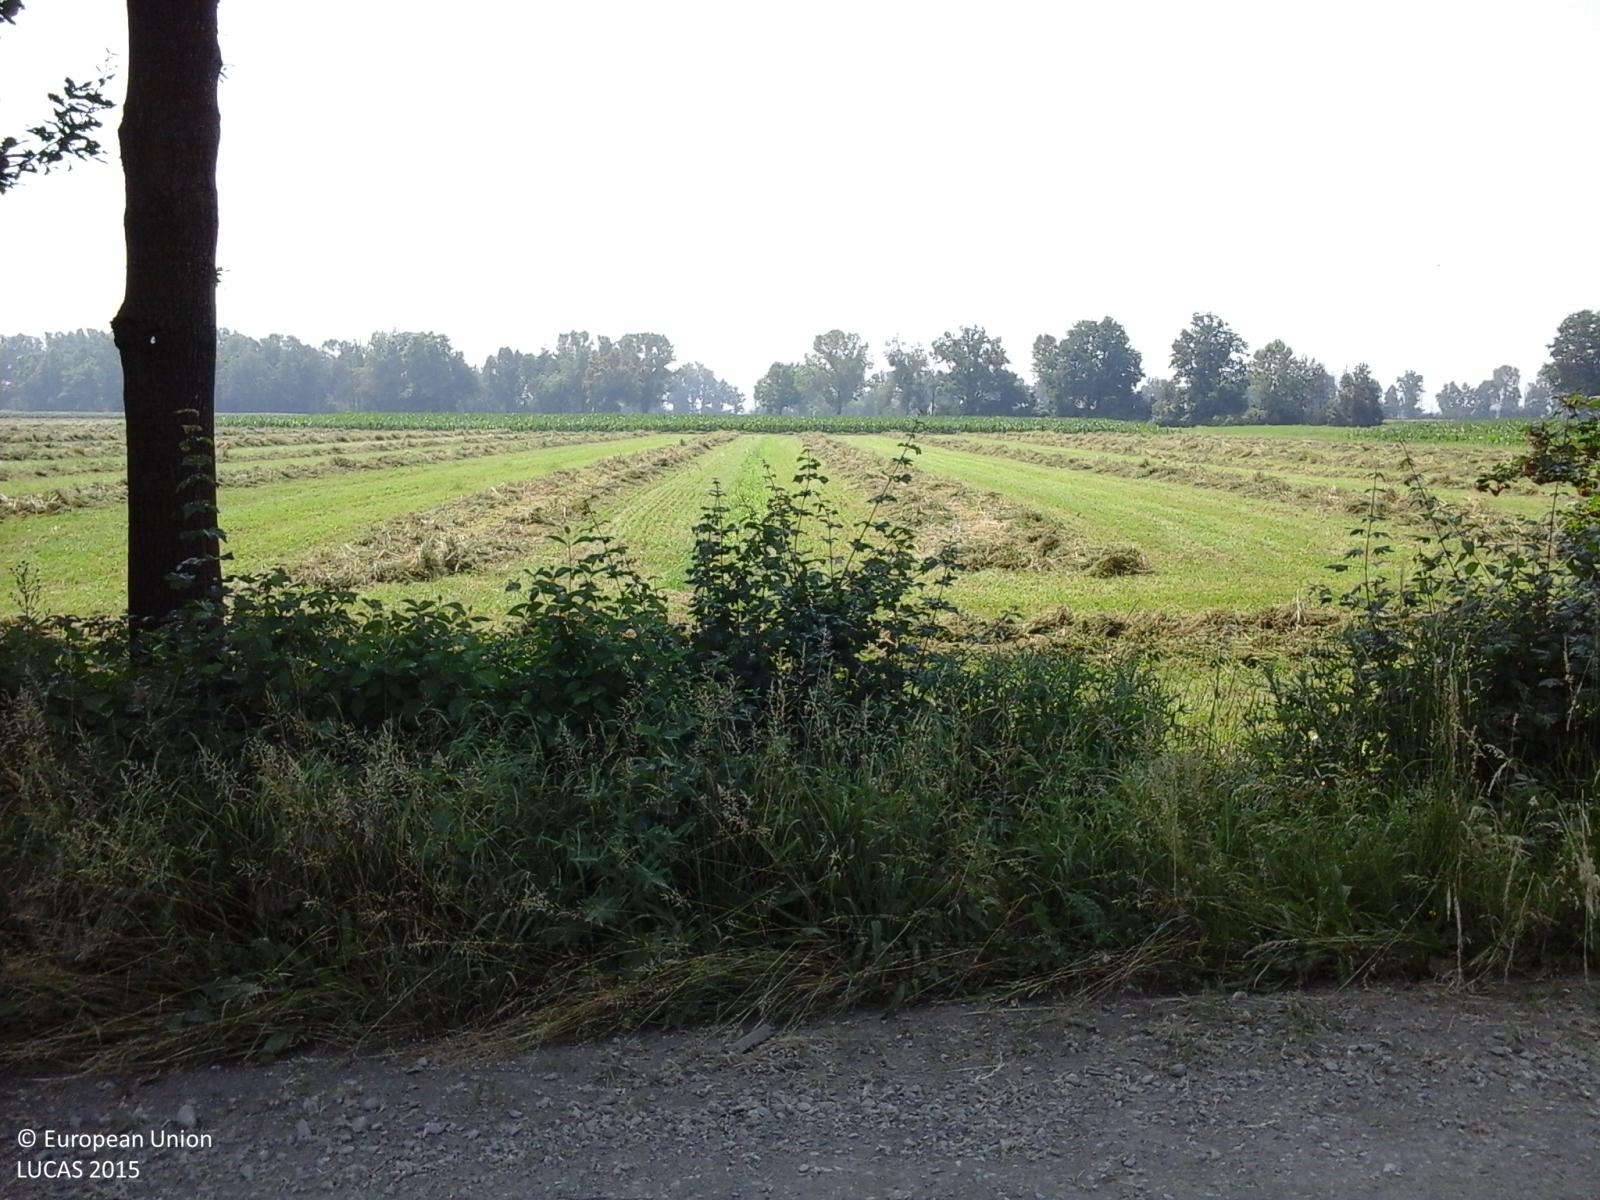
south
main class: Cropland
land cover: Maize
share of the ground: > 75 %
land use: Agriculture (excluding fallow land and kitchen gardens)
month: June
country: IT
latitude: 44.9996
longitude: 10.1646
